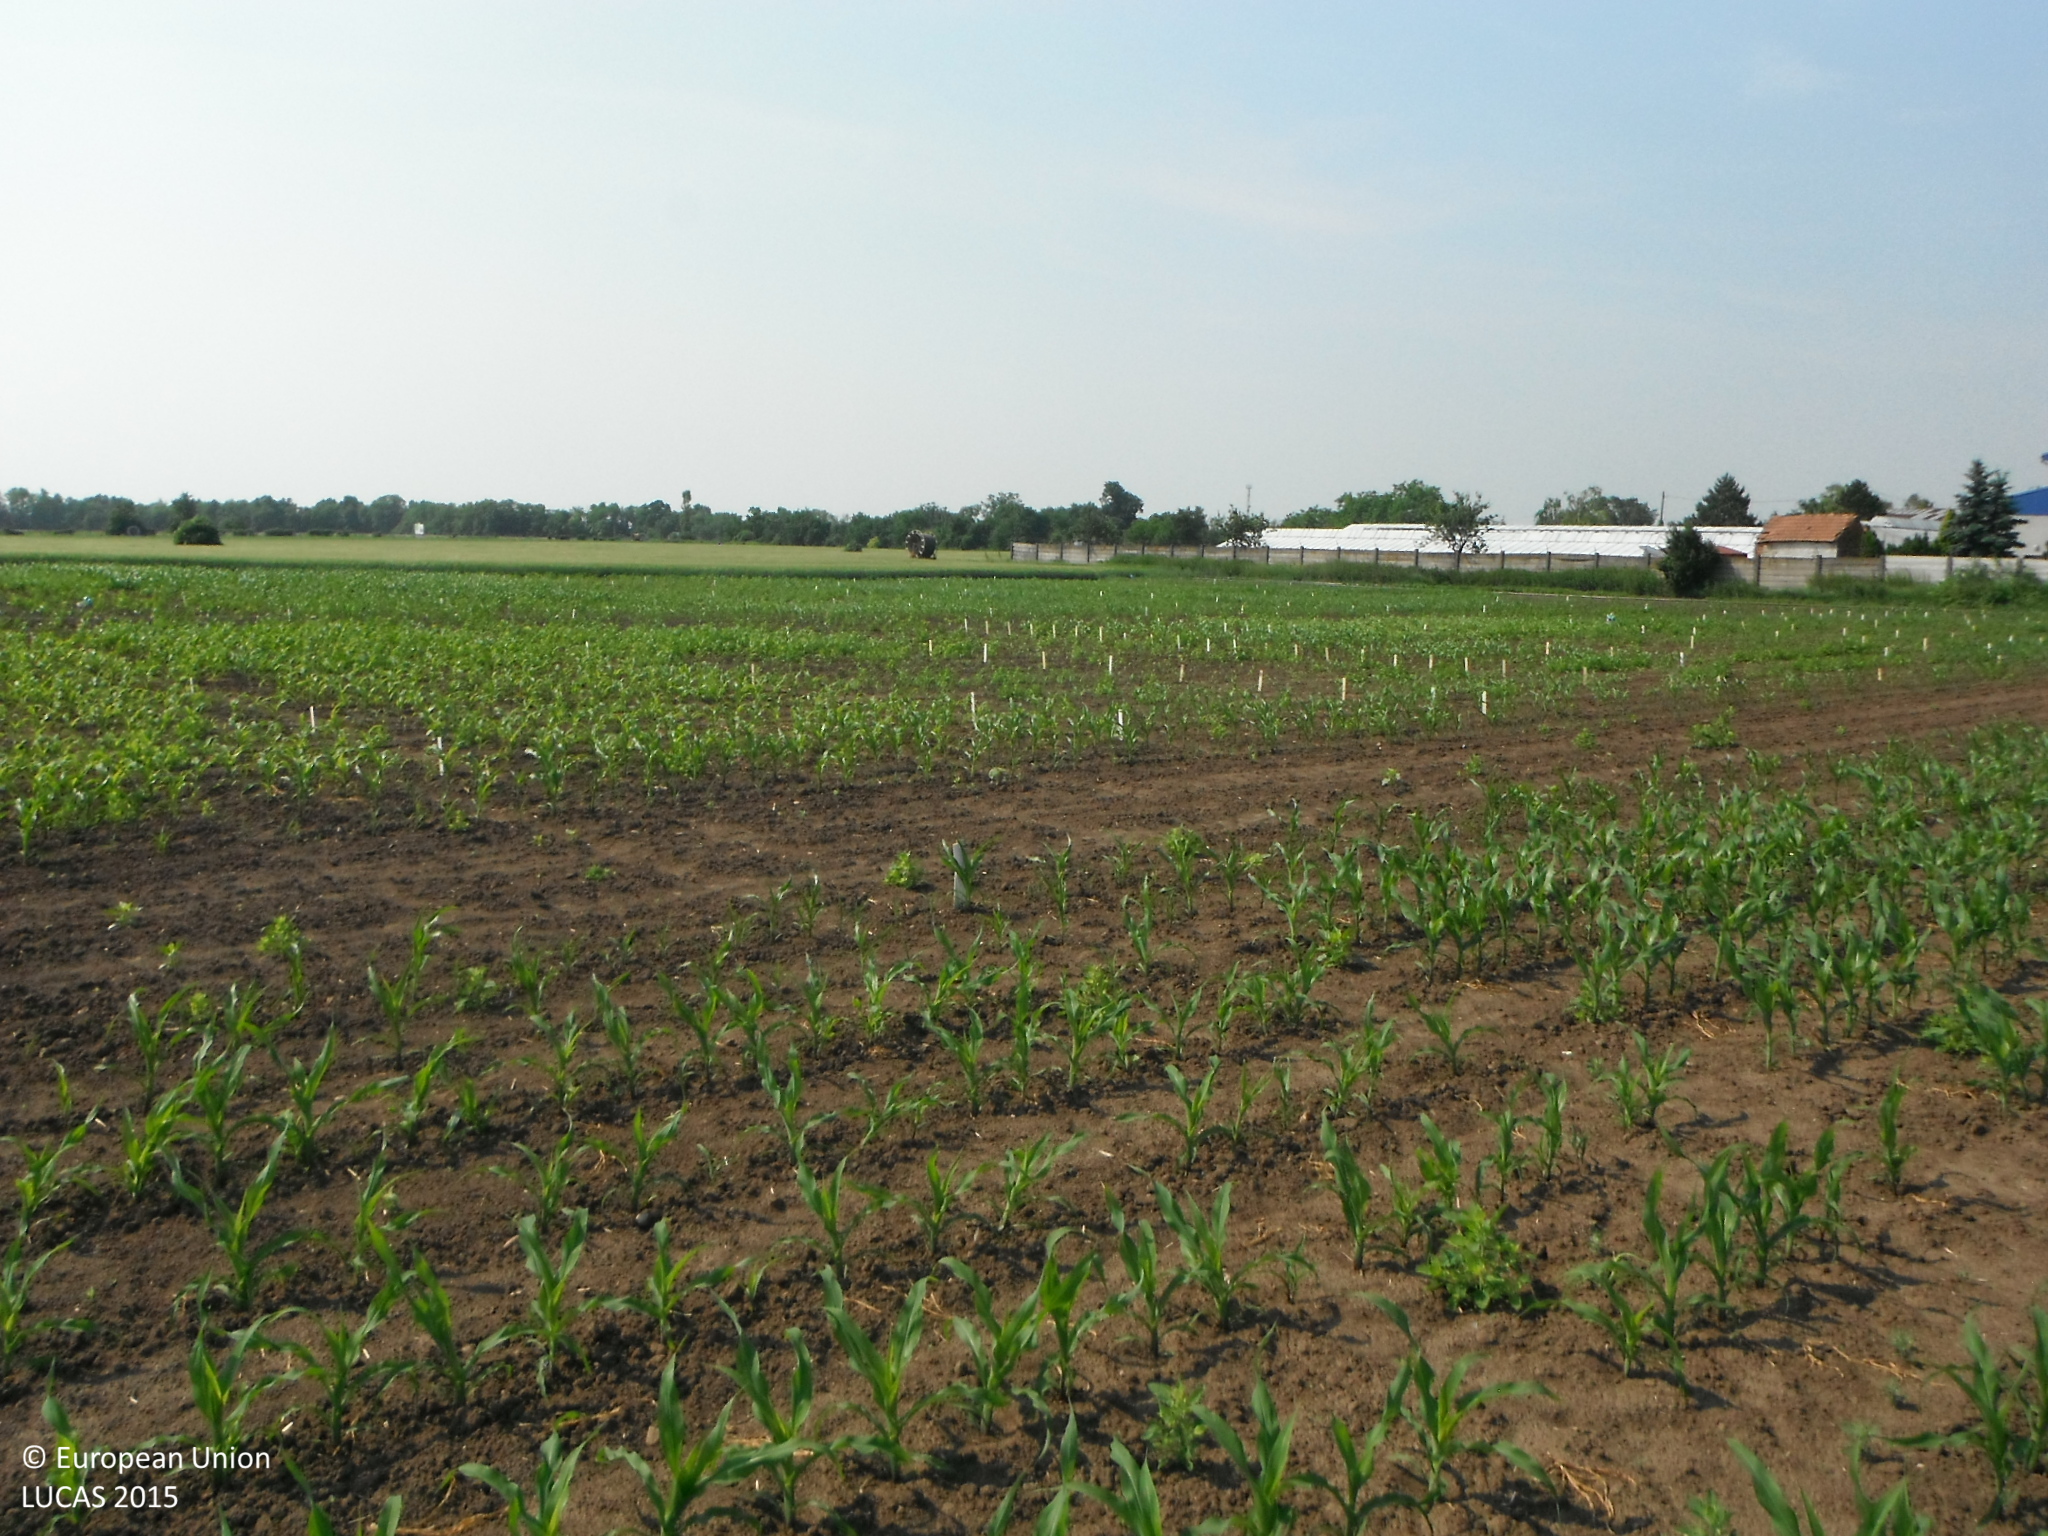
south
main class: Cropland
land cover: Maize
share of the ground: 10 - 25 %
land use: Agriculture (excluding fallow land and kitchen gardens)
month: June
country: SK
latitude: 48.3814
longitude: 17.5313
